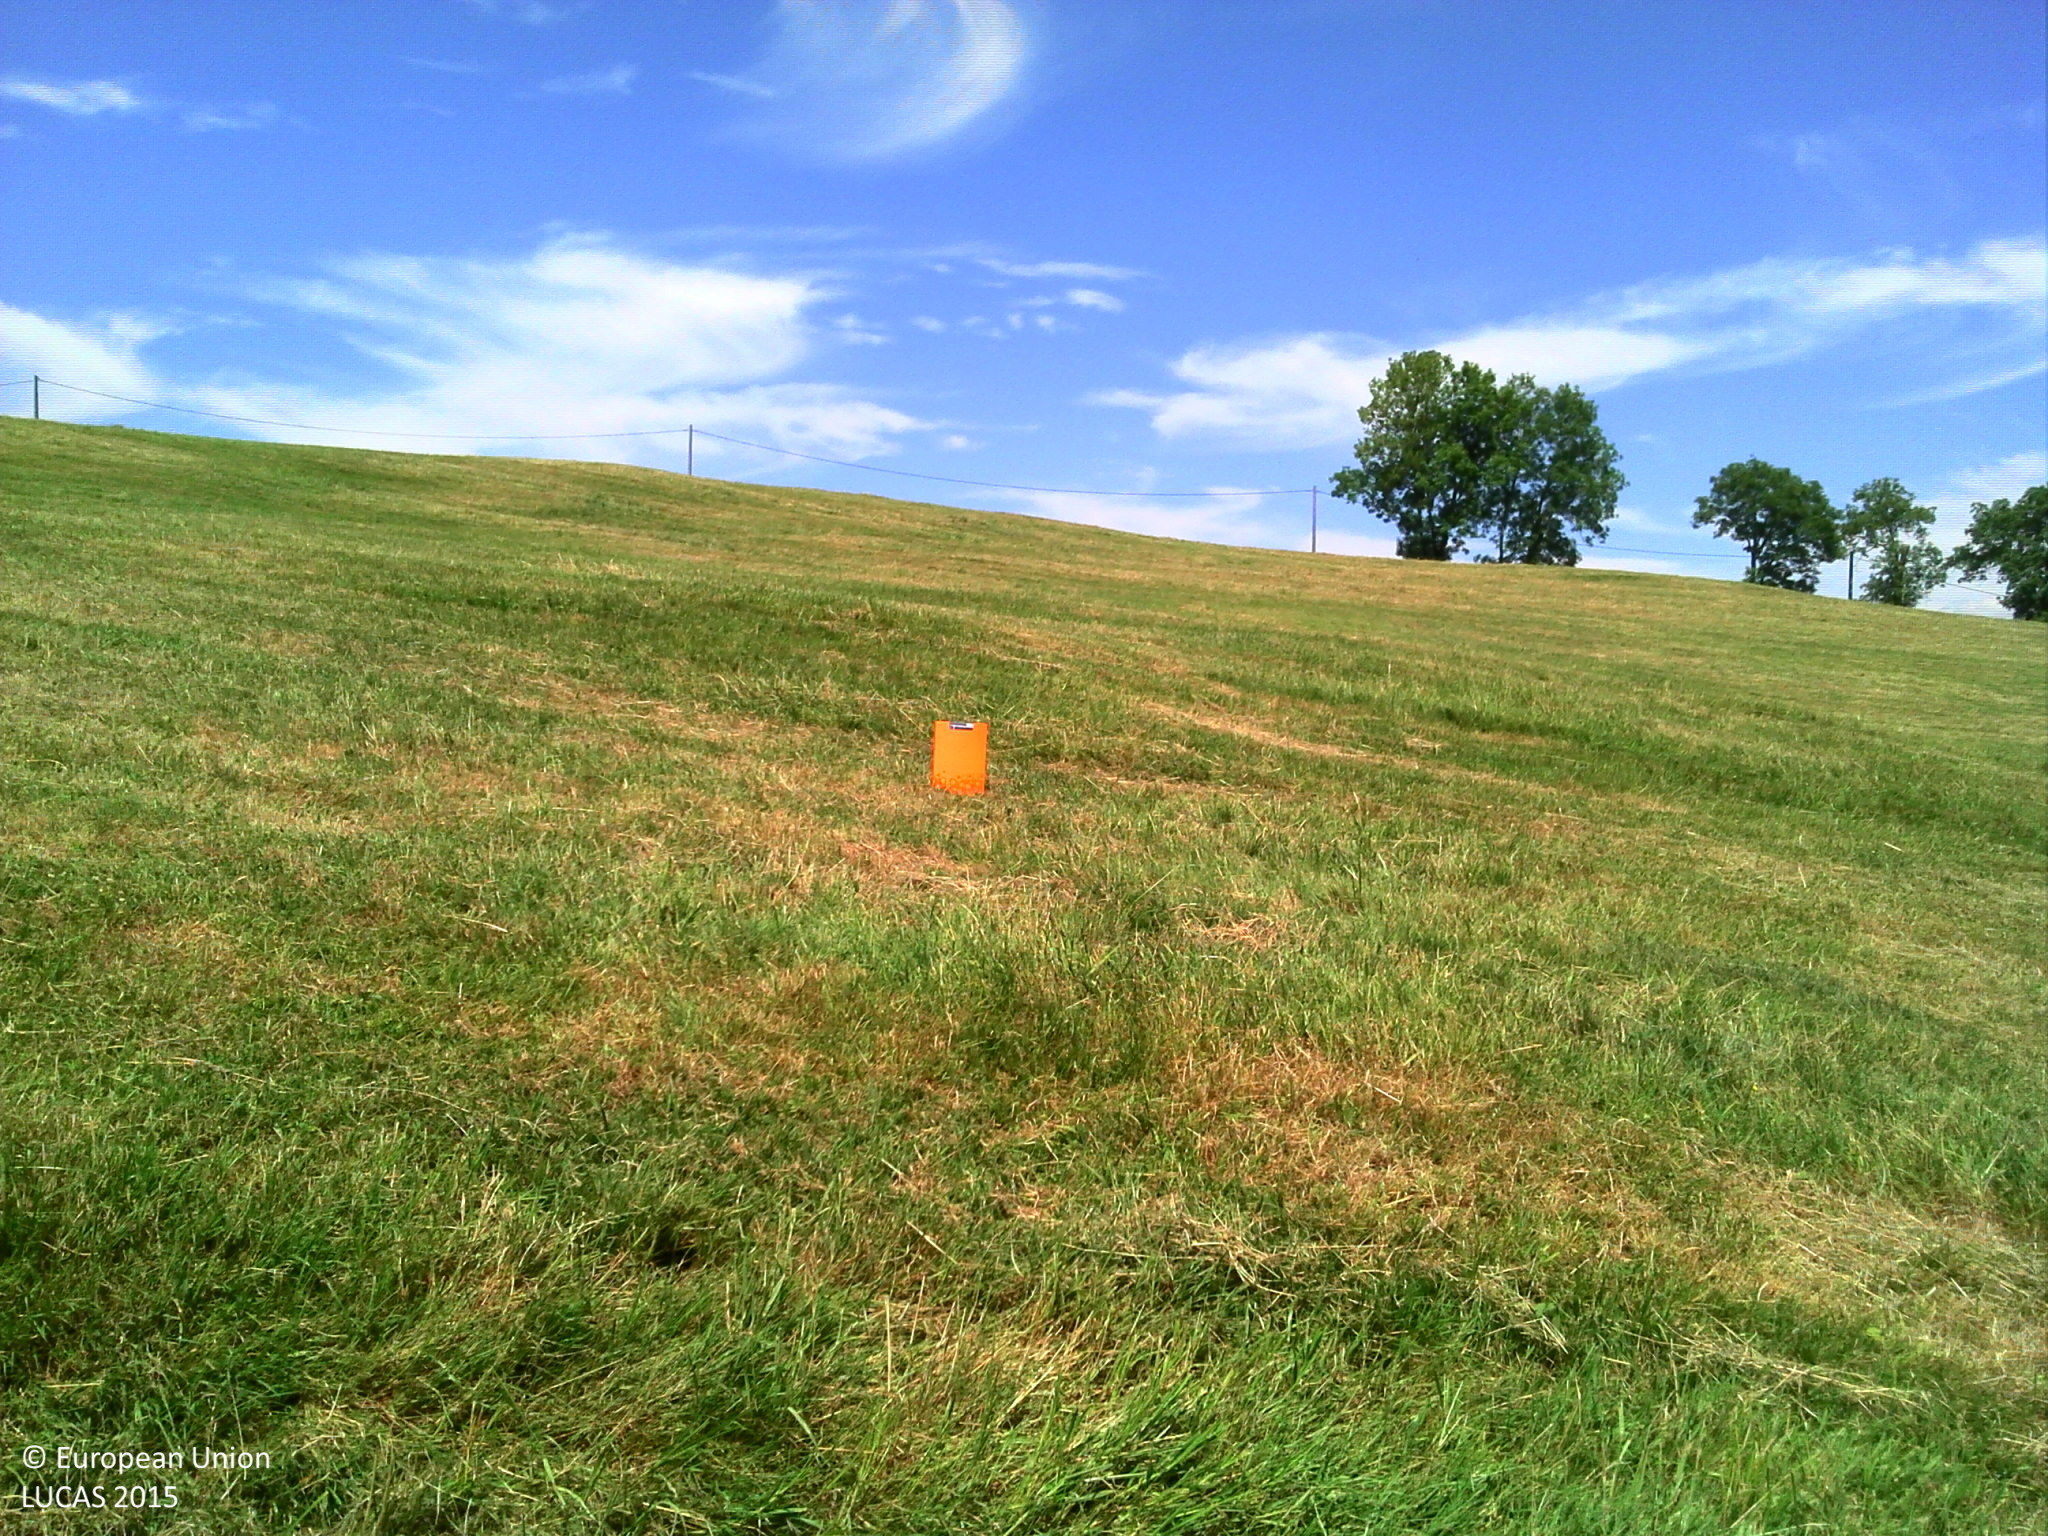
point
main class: Grassland
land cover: Grassland without tree/shrub cover
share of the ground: > 75 %
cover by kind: herbaceous plants 100 %
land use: Agriculture (excluding fallow land and kitchen gardens)
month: June
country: FR
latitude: 44.9574
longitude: 2.3816
